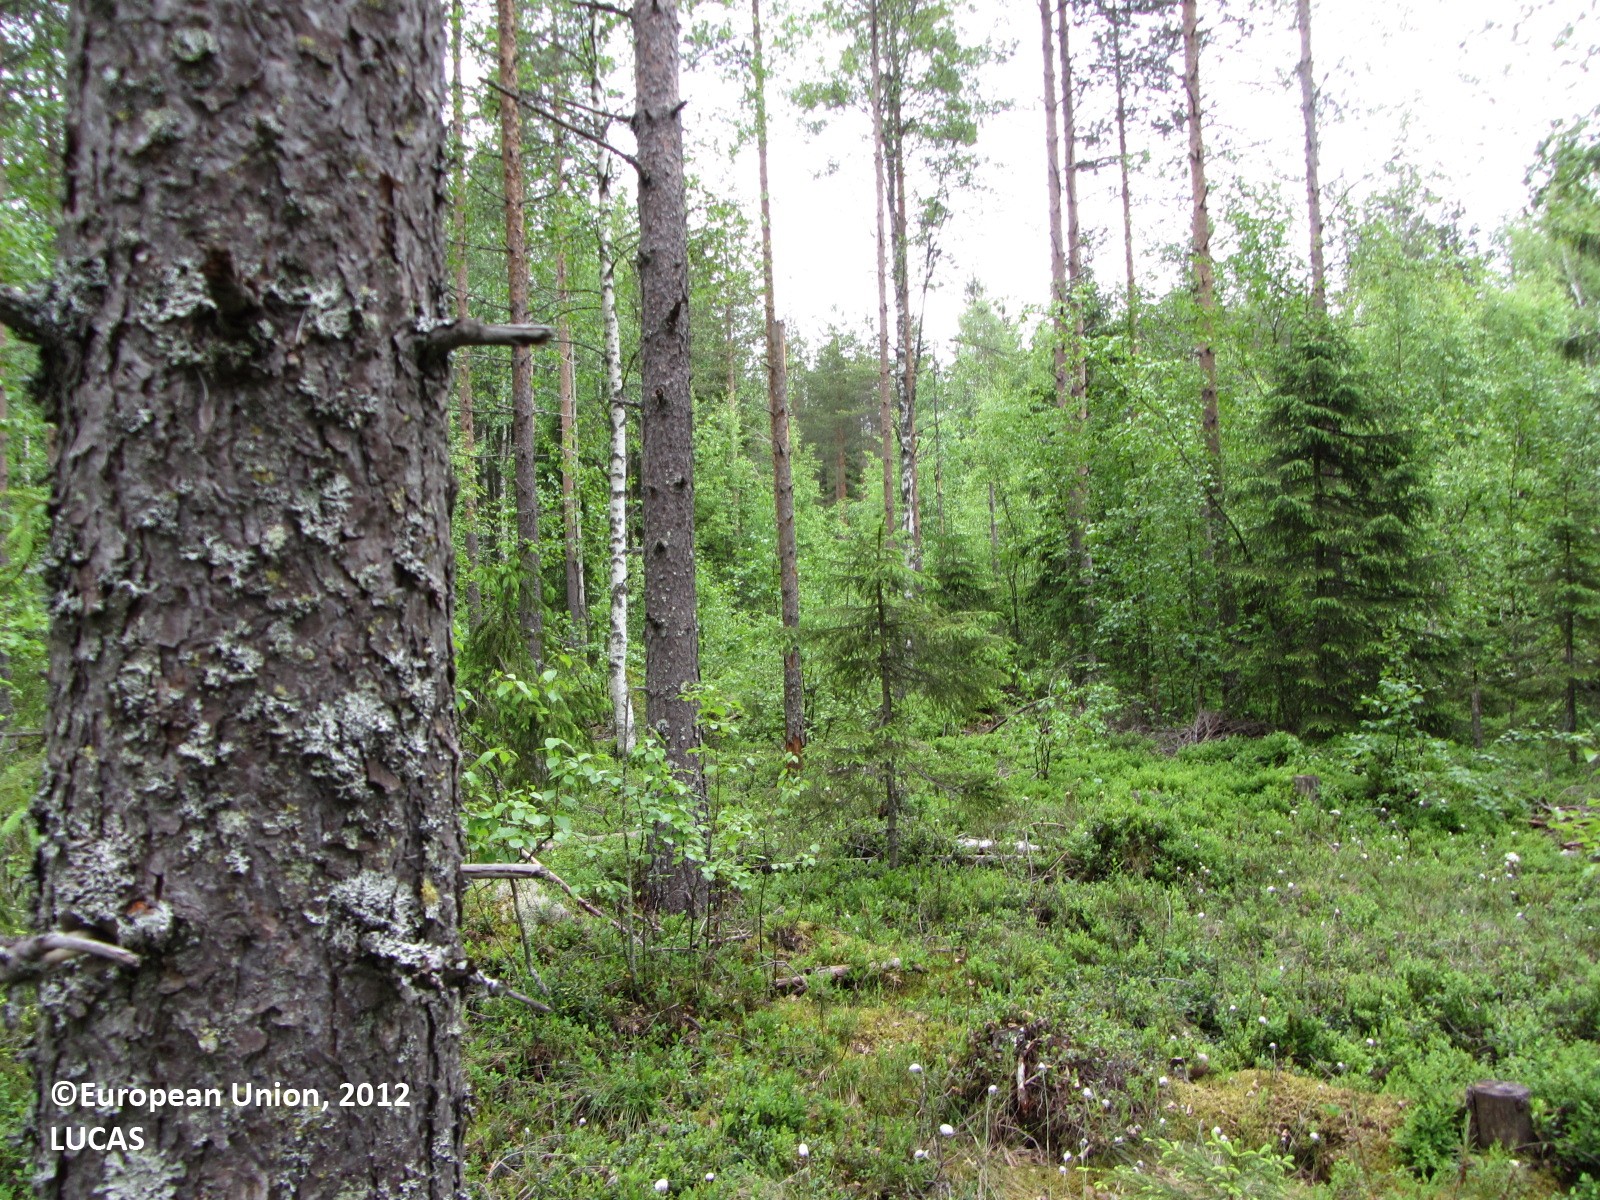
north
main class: Woodland
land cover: Other mixed woodland
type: boreal forest
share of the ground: 50 - 75 %
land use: Forestry
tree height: > 5 m
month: June
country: FI
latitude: 62.4286
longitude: 25.1520
